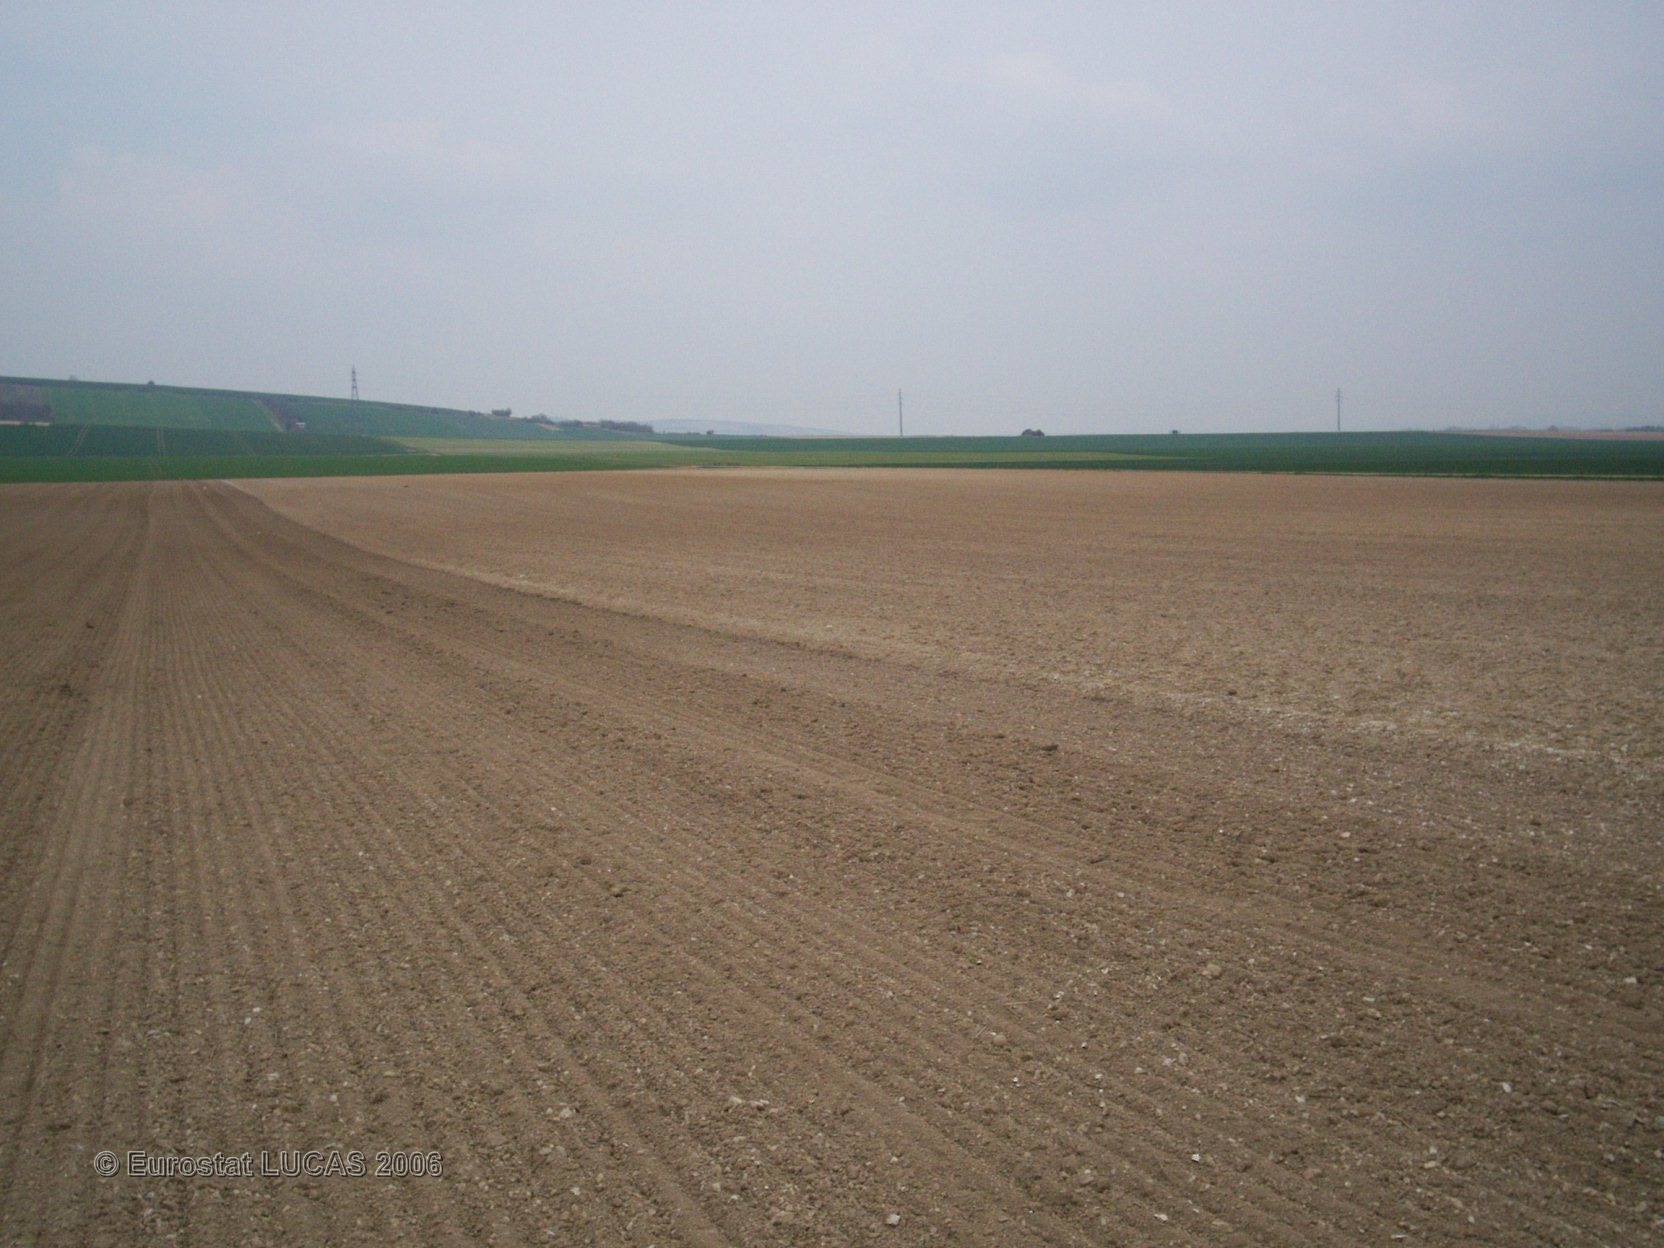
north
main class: Cropland
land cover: Sugar beet
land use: Agriculture (excluding fallow land and kitchen gardens)
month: May
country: FR
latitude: 48.2393
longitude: 3.9773
